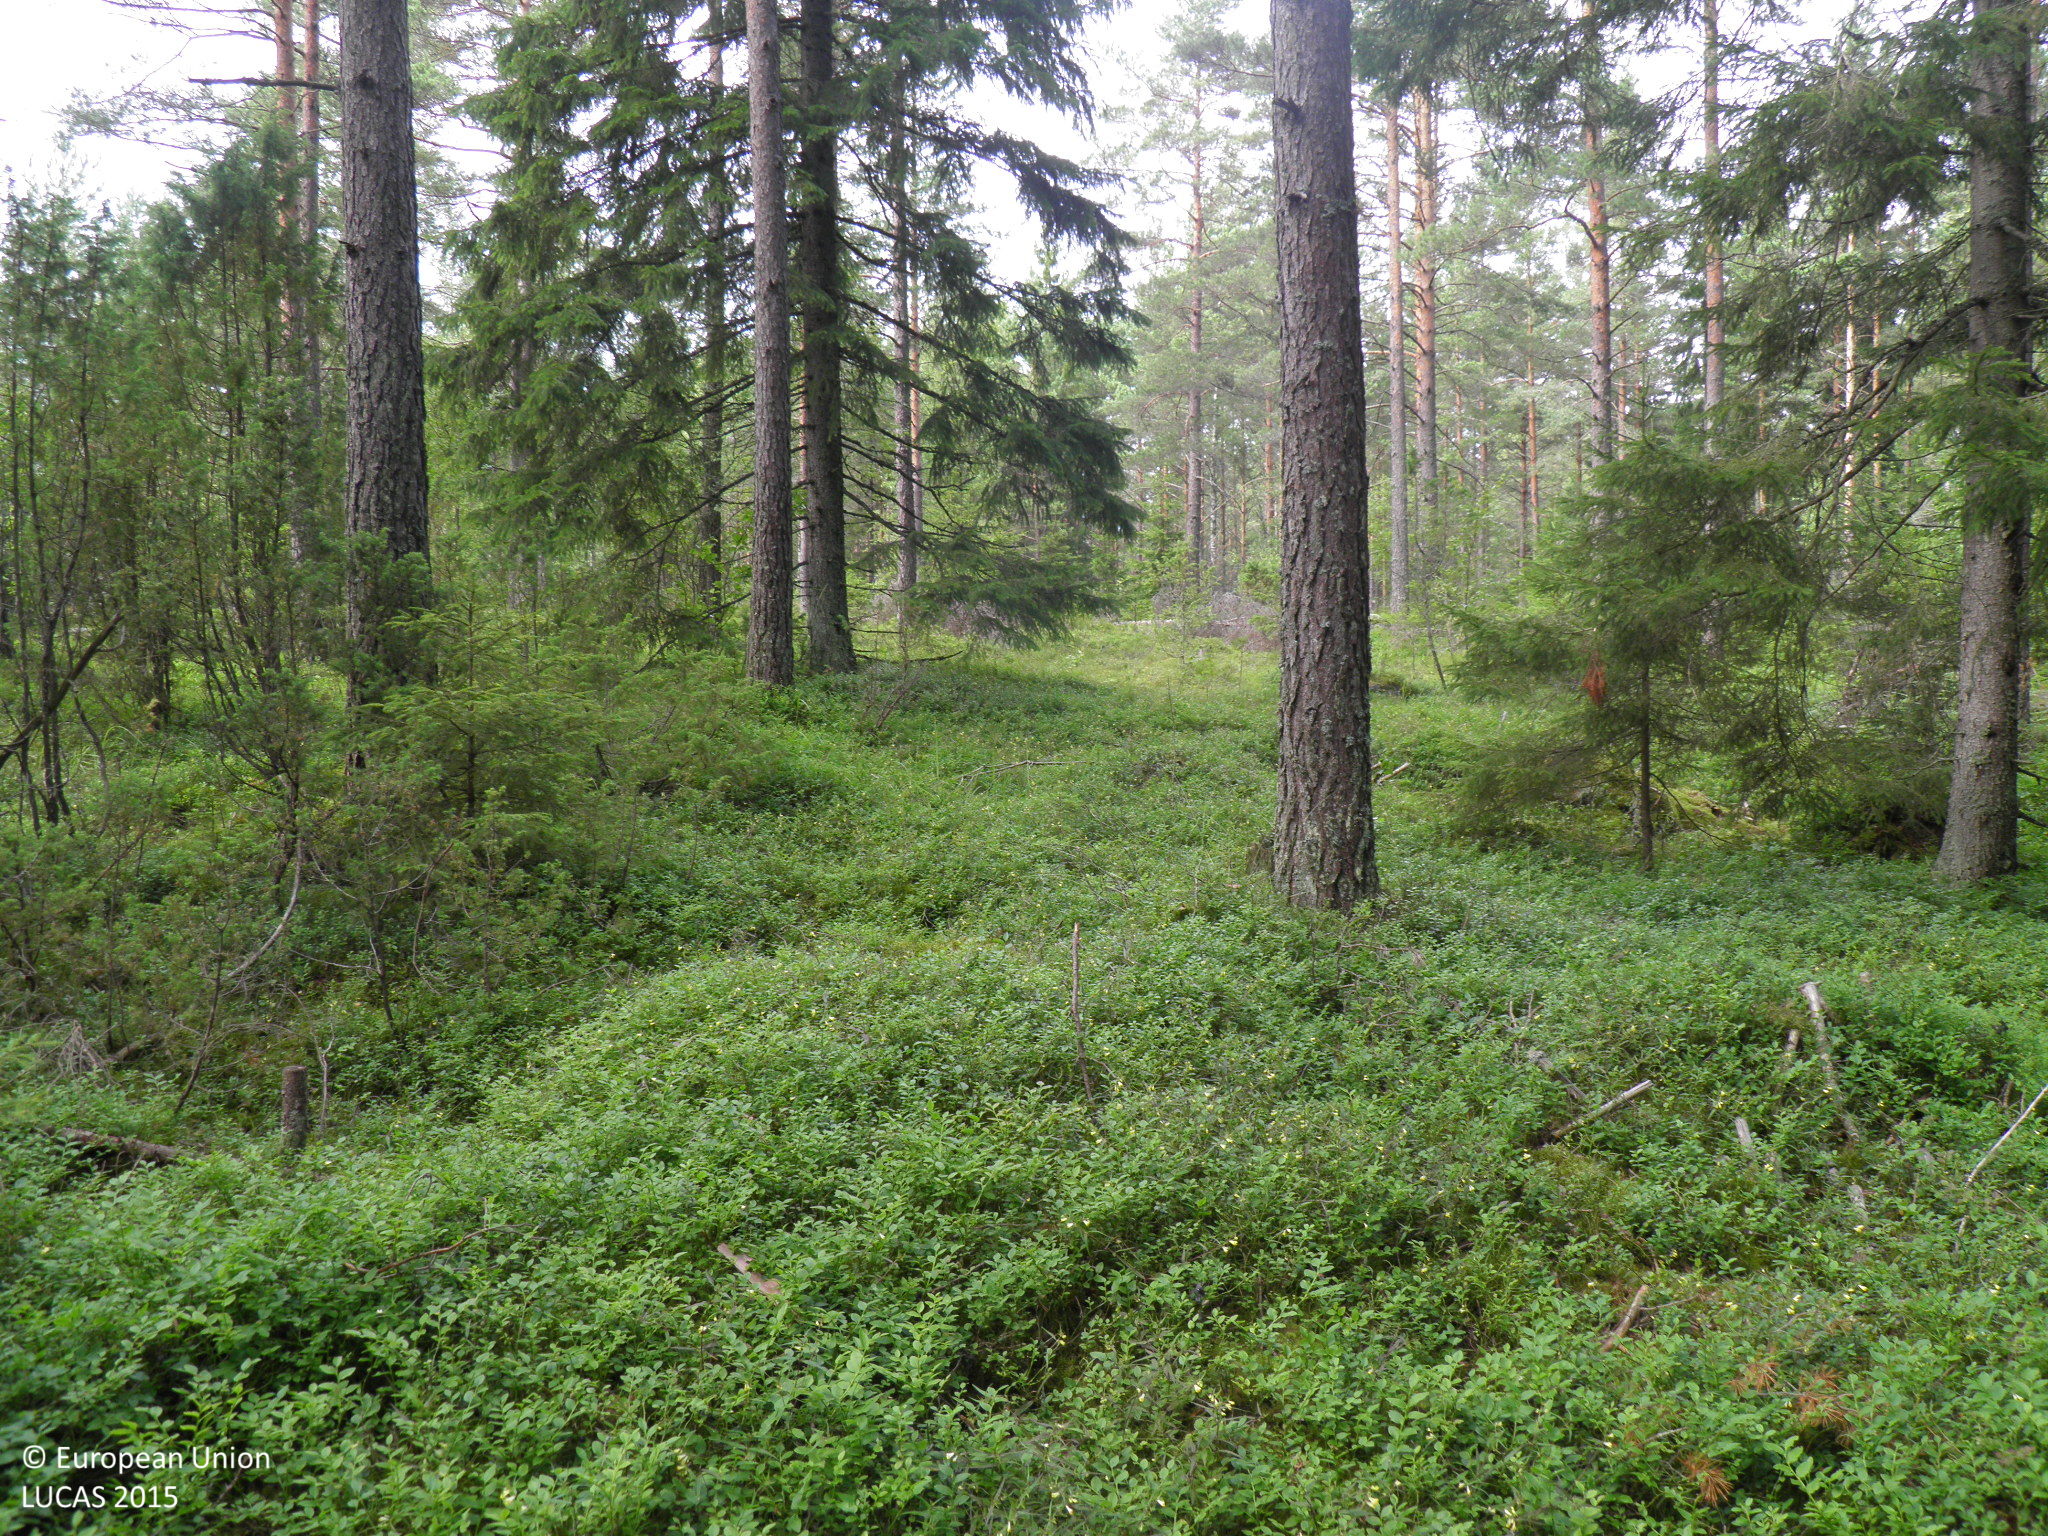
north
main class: Woodland
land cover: Spruce dominated coniferous woodland
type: boreal forest
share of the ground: 50 - 75 %
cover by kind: shrubs 50 %, coniferous forest trees 40 %, broadleaved forest trees 10 %
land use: Forestry
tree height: > 5 m
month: July
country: FI
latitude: 60.0583
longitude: 22.5208
